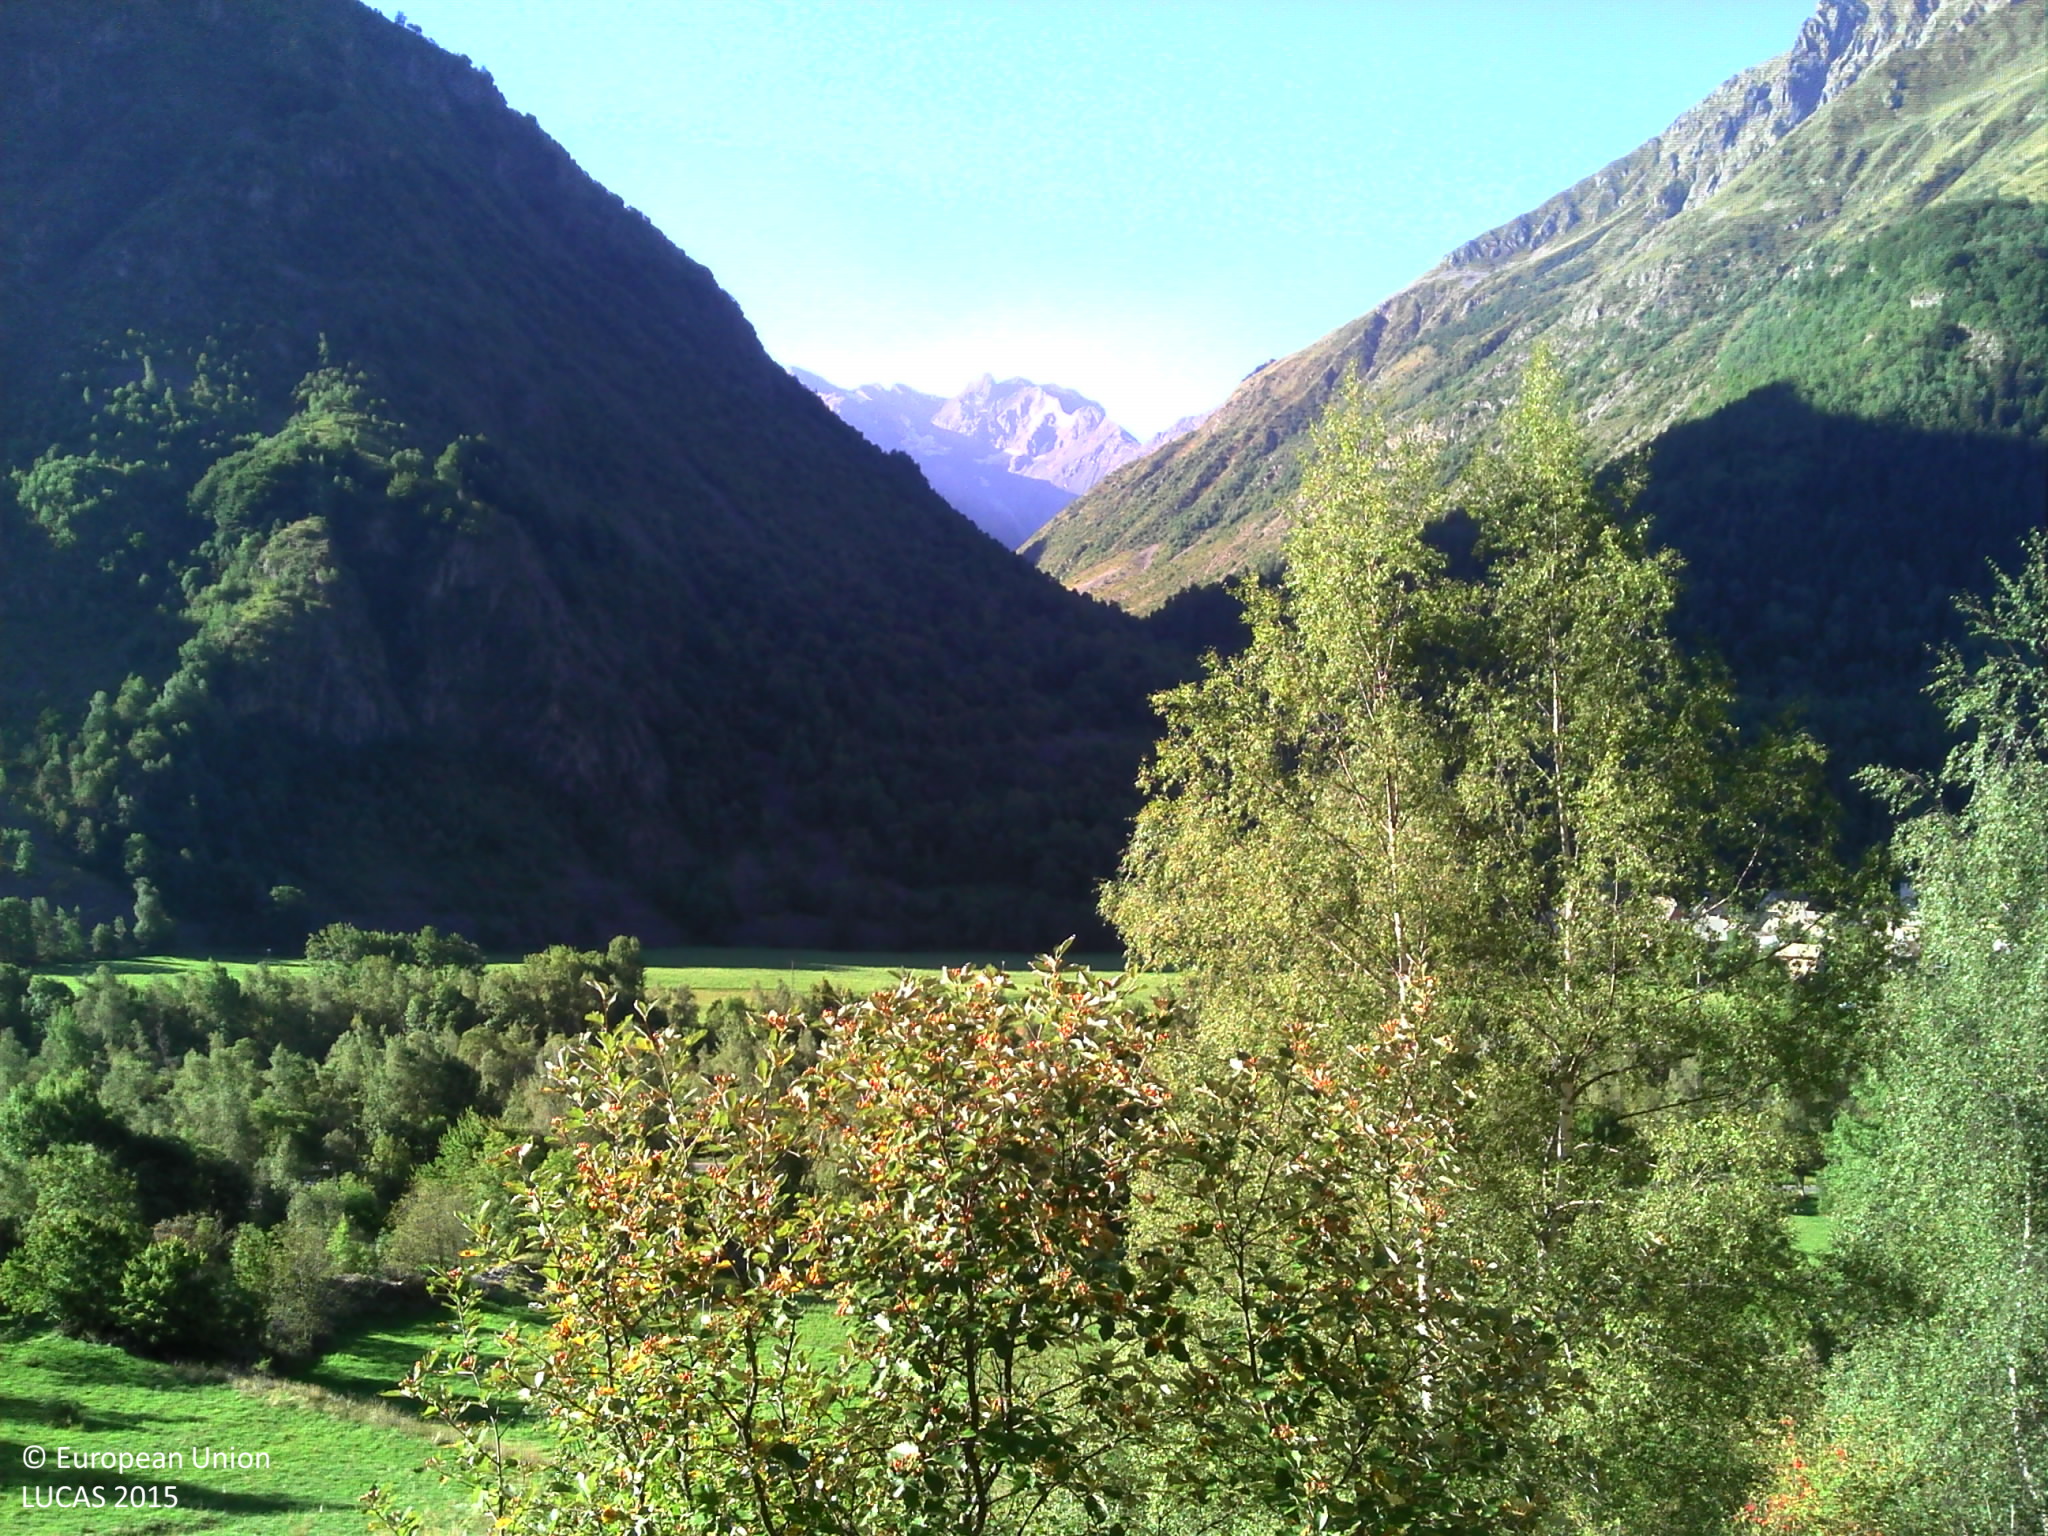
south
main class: Shrubland
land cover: Shrubland with sparse tree cover
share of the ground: > 75 %
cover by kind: consolidated bare surface 60 %, herbaceous plants 20 %, shrubs 15 %, broadleaved forest trees 5 %
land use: Semi-natural and natural areas not in use
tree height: > 5 m
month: August
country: FR
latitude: 44.8225
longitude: 6.1993
